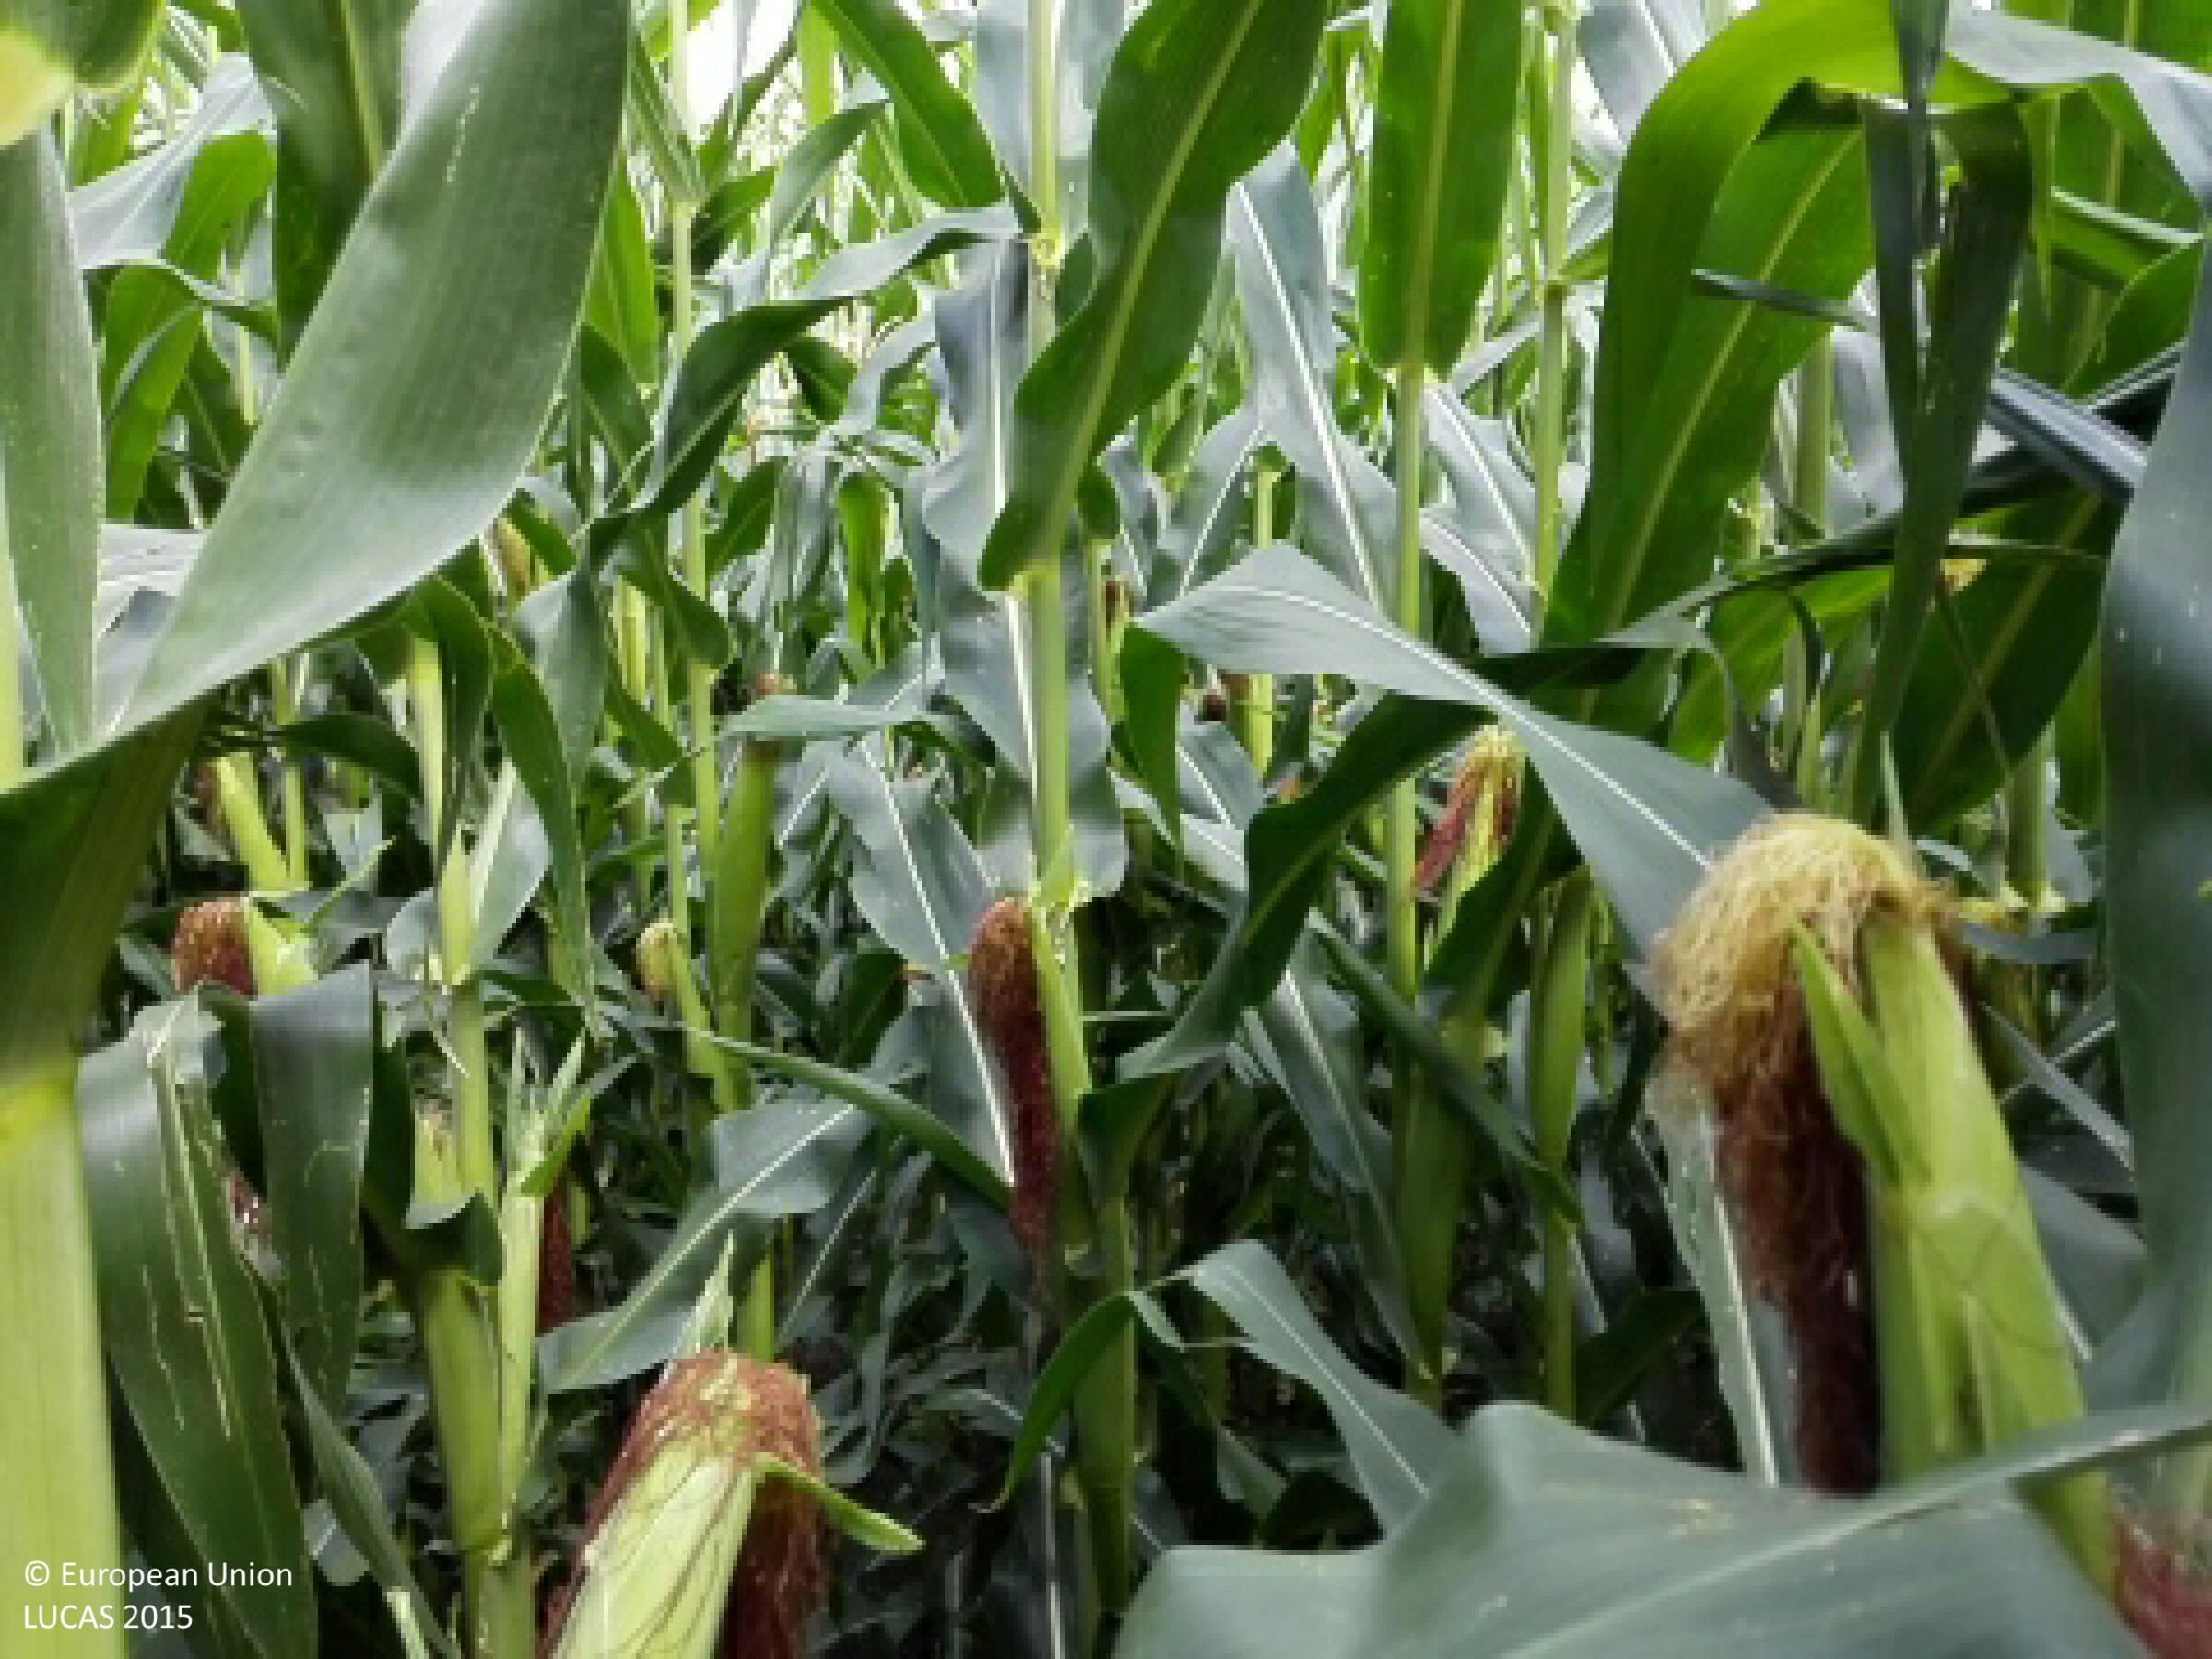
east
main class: Cropland
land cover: Maize
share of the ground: > 75 %
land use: Agriculture (excluding fallow land and kitchen gardens)
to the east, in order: Maize; Electric lines; Maize
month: July
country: HU
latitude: 47.5596
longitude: 21.3781
